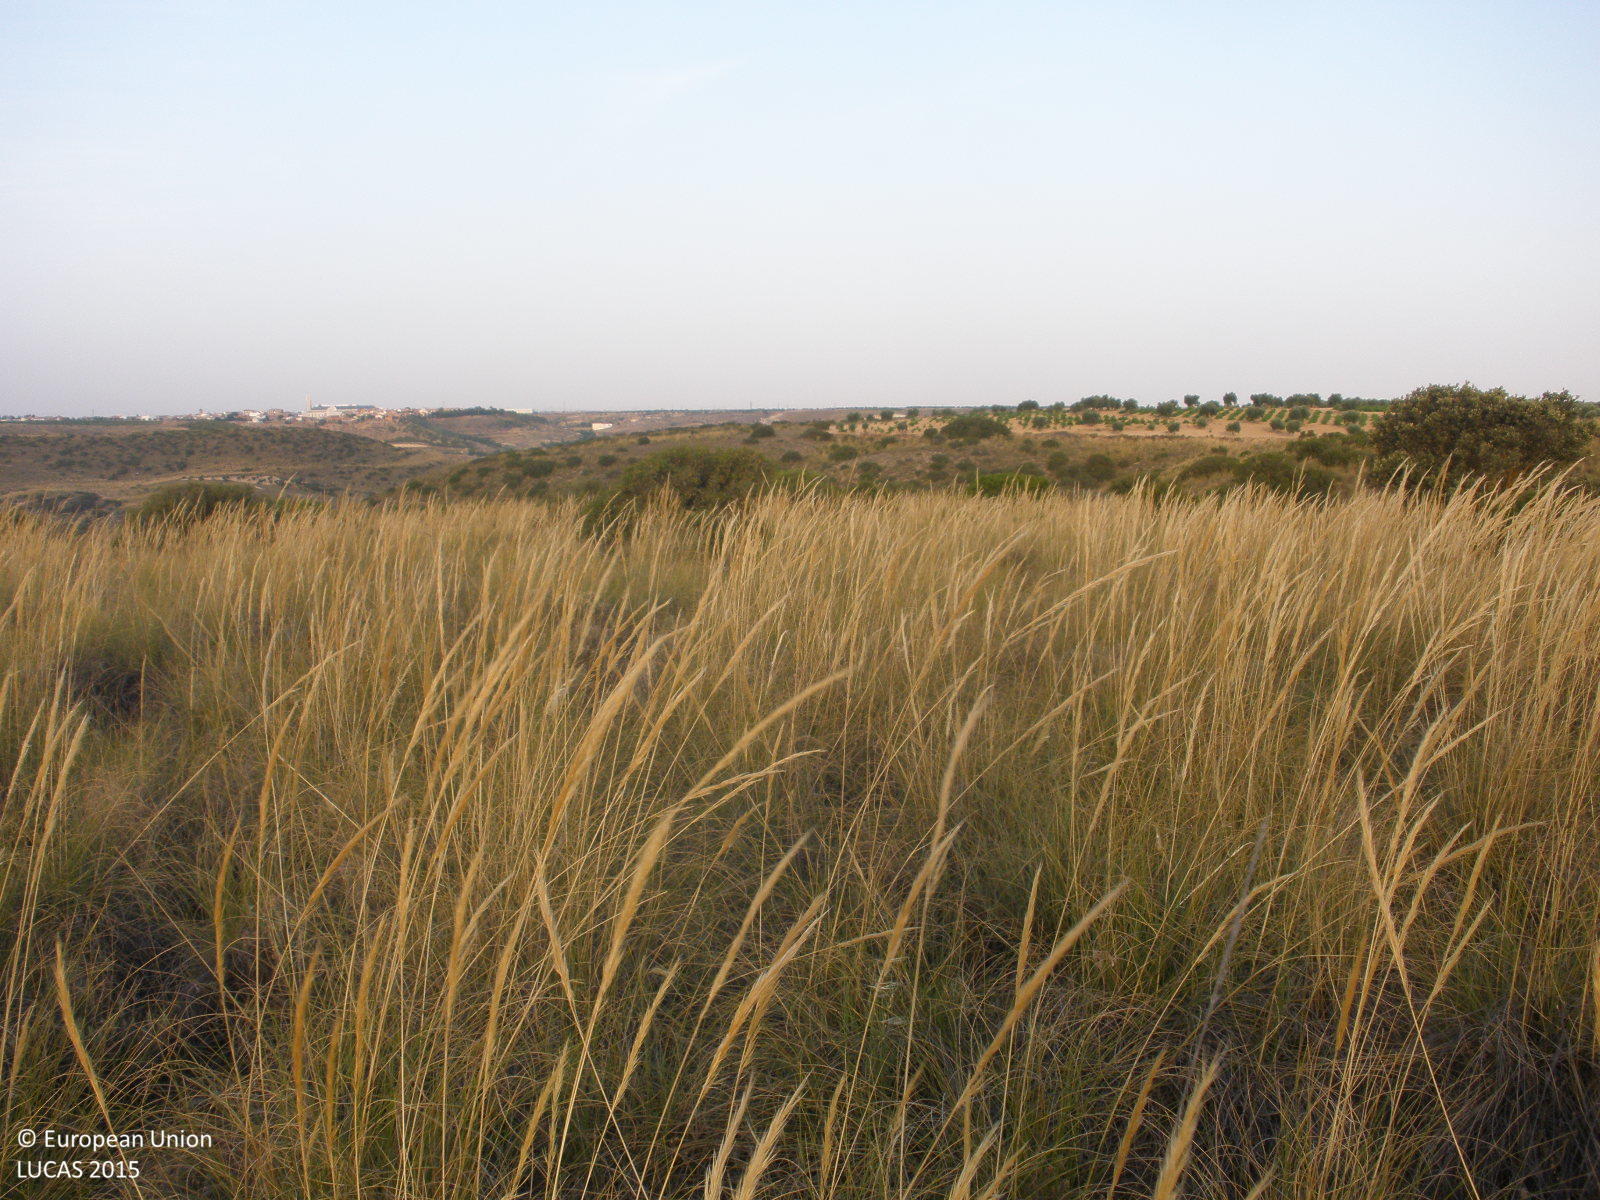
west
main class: Shrubland
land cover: Shrubland without tree cover
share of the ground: 25 - 50 %
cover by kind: herbaceous plants 50 %, shrubs 40 %, consolidated bare surface 10 %
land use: Semi-natural and natural areas not in use
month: July
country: ES
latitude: 40.0004
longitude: -3.4168
